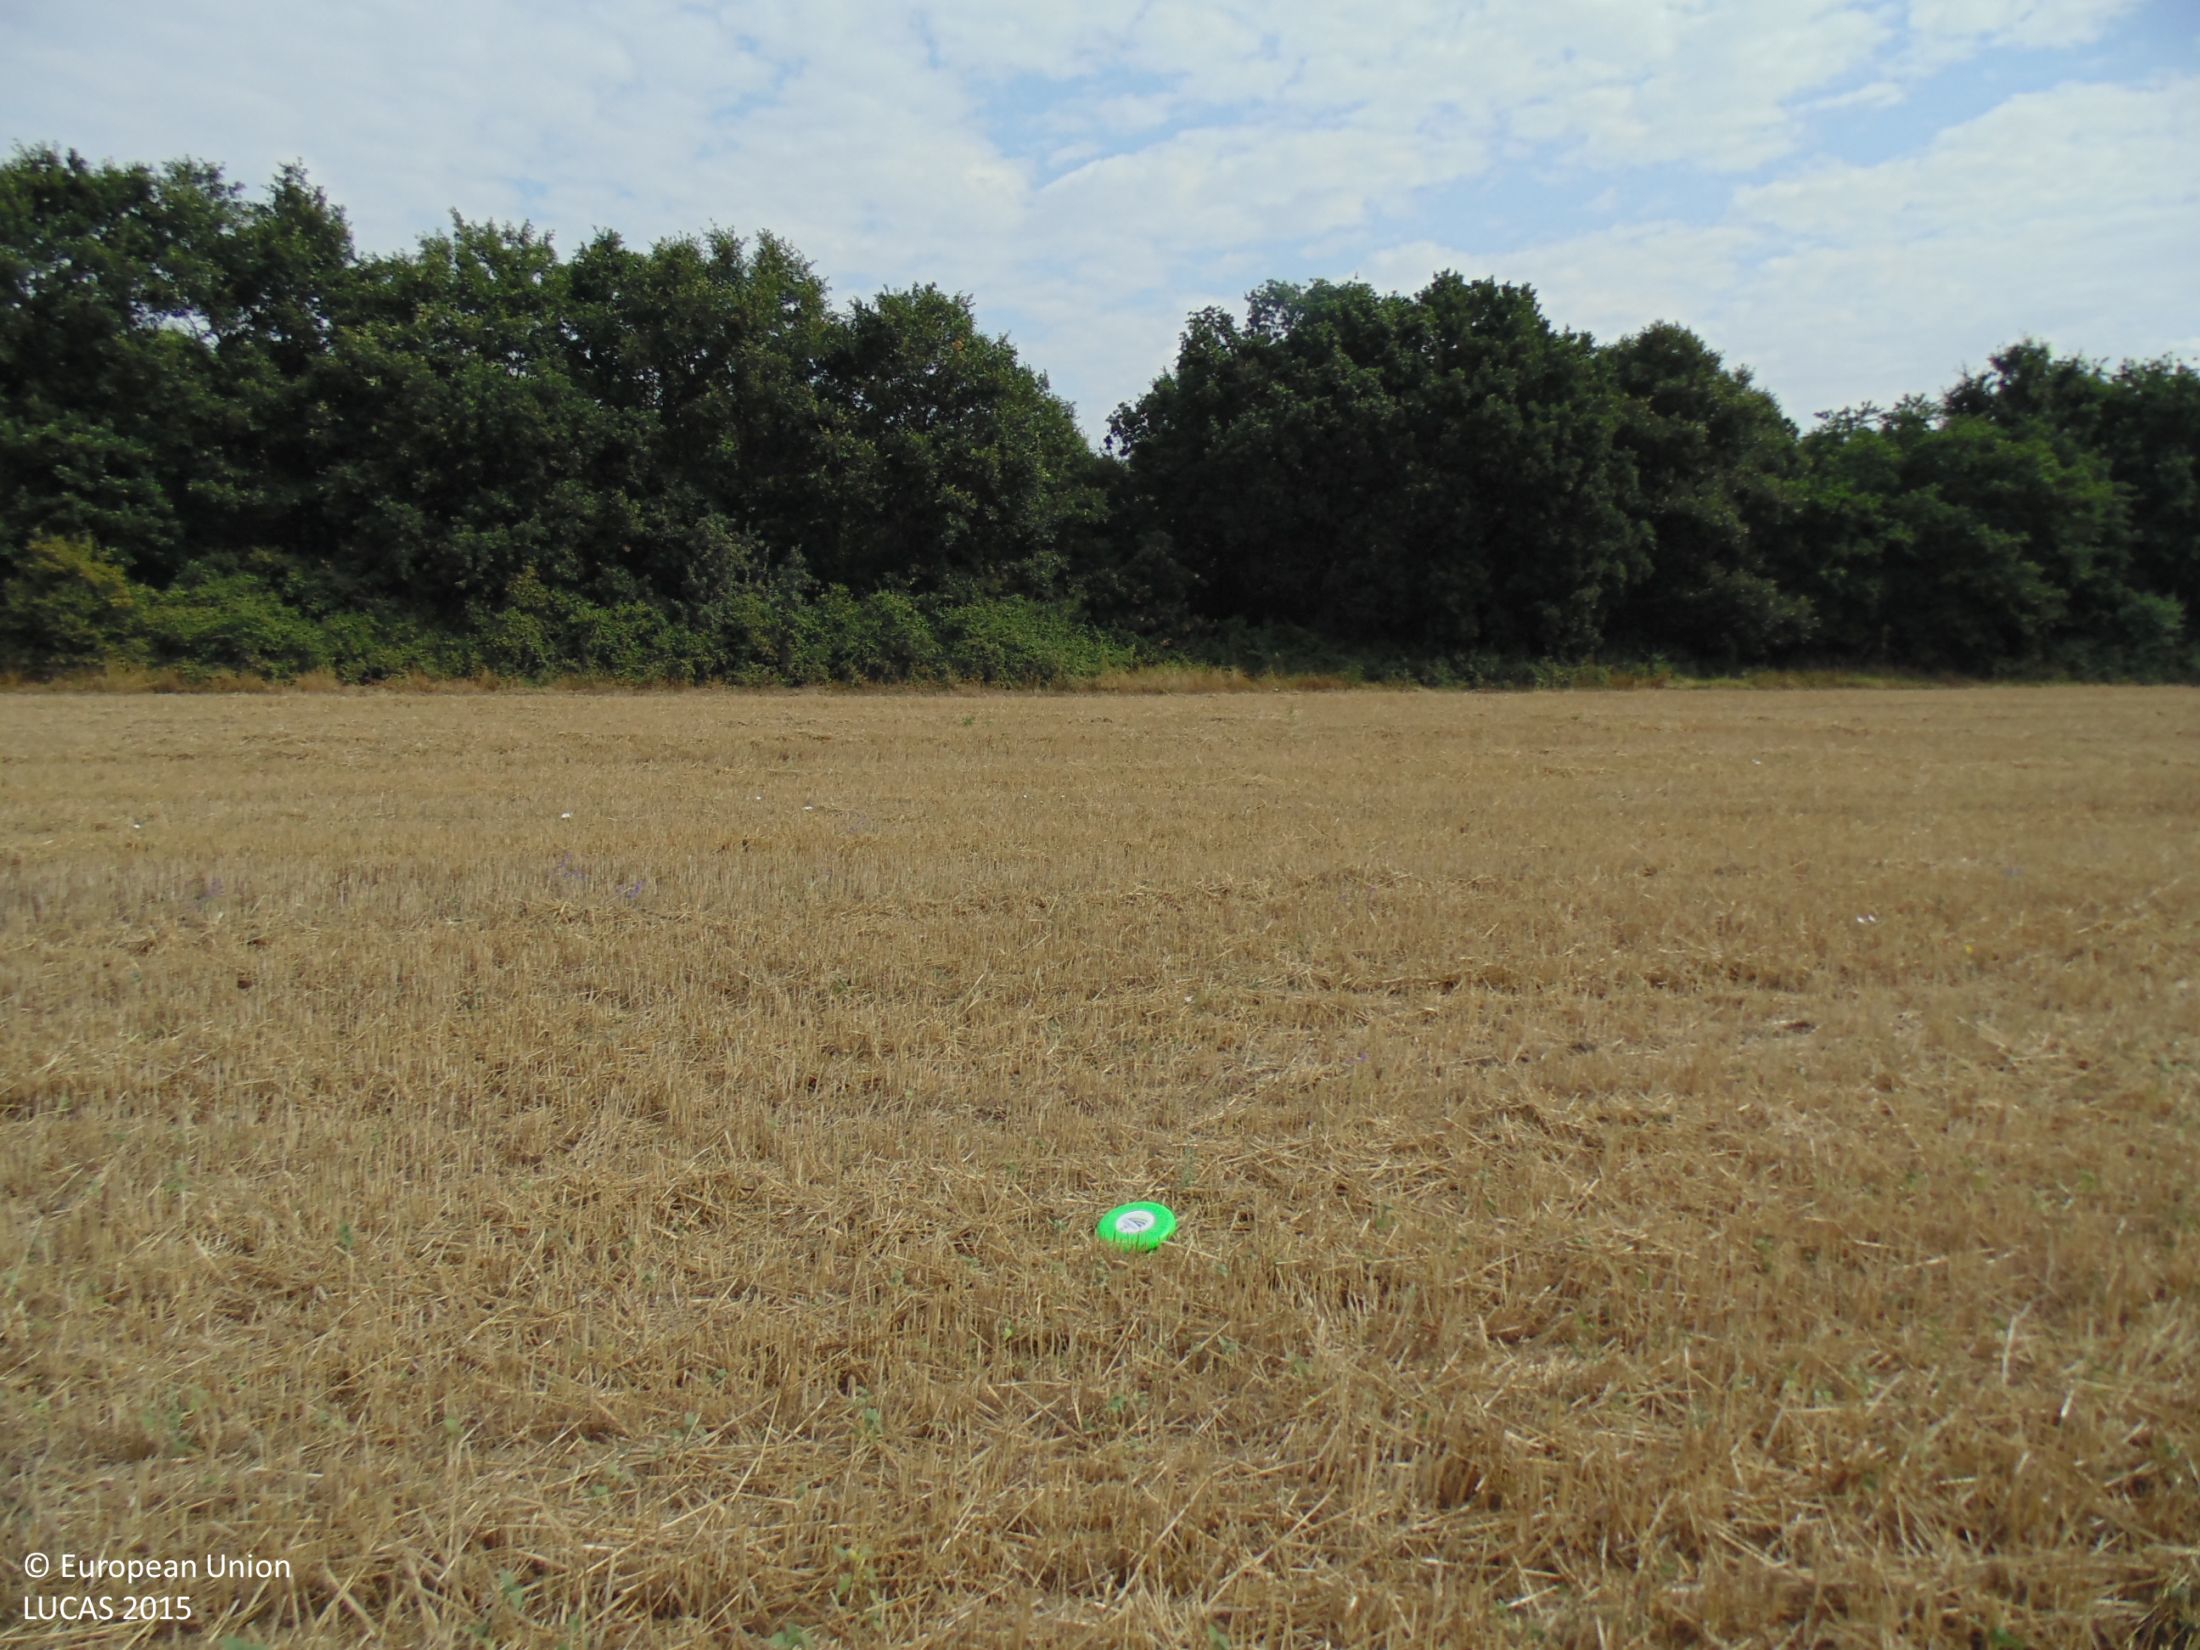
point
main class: Cropland
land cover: Common wheat
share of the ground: 25 - 50 %
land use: Agriculture (excluding fallow land and kitchen gardens)
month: August
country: BG
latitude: 43.7560
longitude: 27.6892
